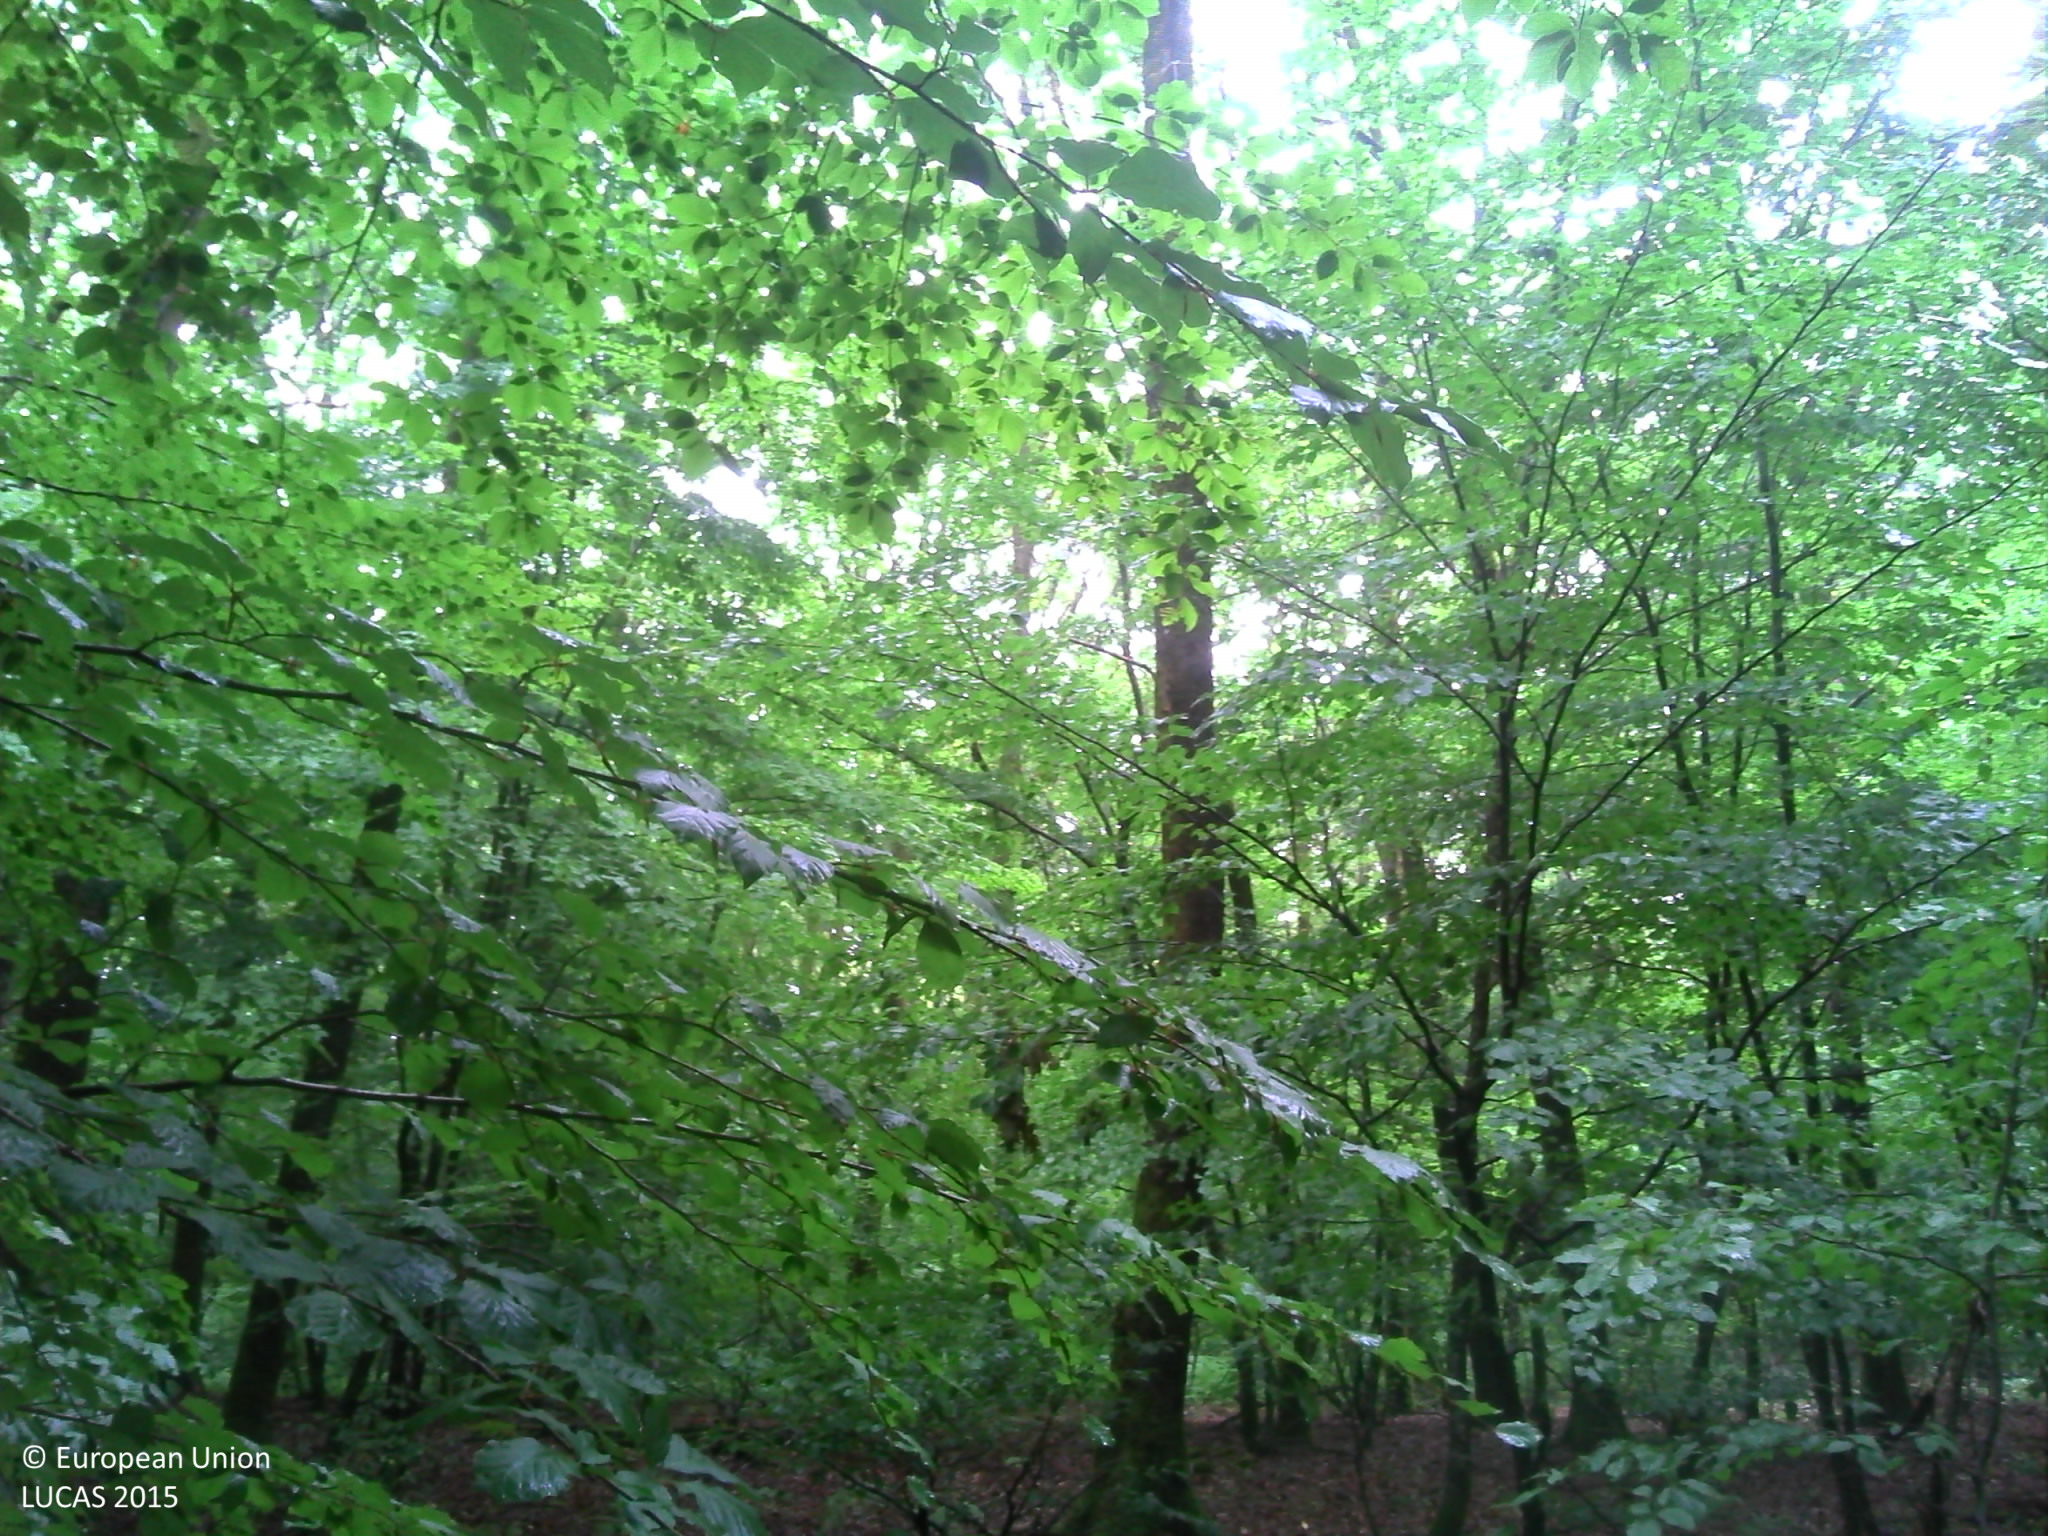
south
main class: Woodland
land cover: Broadleaved woodland
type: acidophilous oak and oak-birch forest
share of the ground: > 75 %
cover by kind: broadleaved forest trees 95 %, lichens and mosses 5 %
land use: Forestry
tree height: > 5 m
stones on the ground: < 10 %
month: June
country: FR
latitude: 47.2560
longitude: 3.2169
